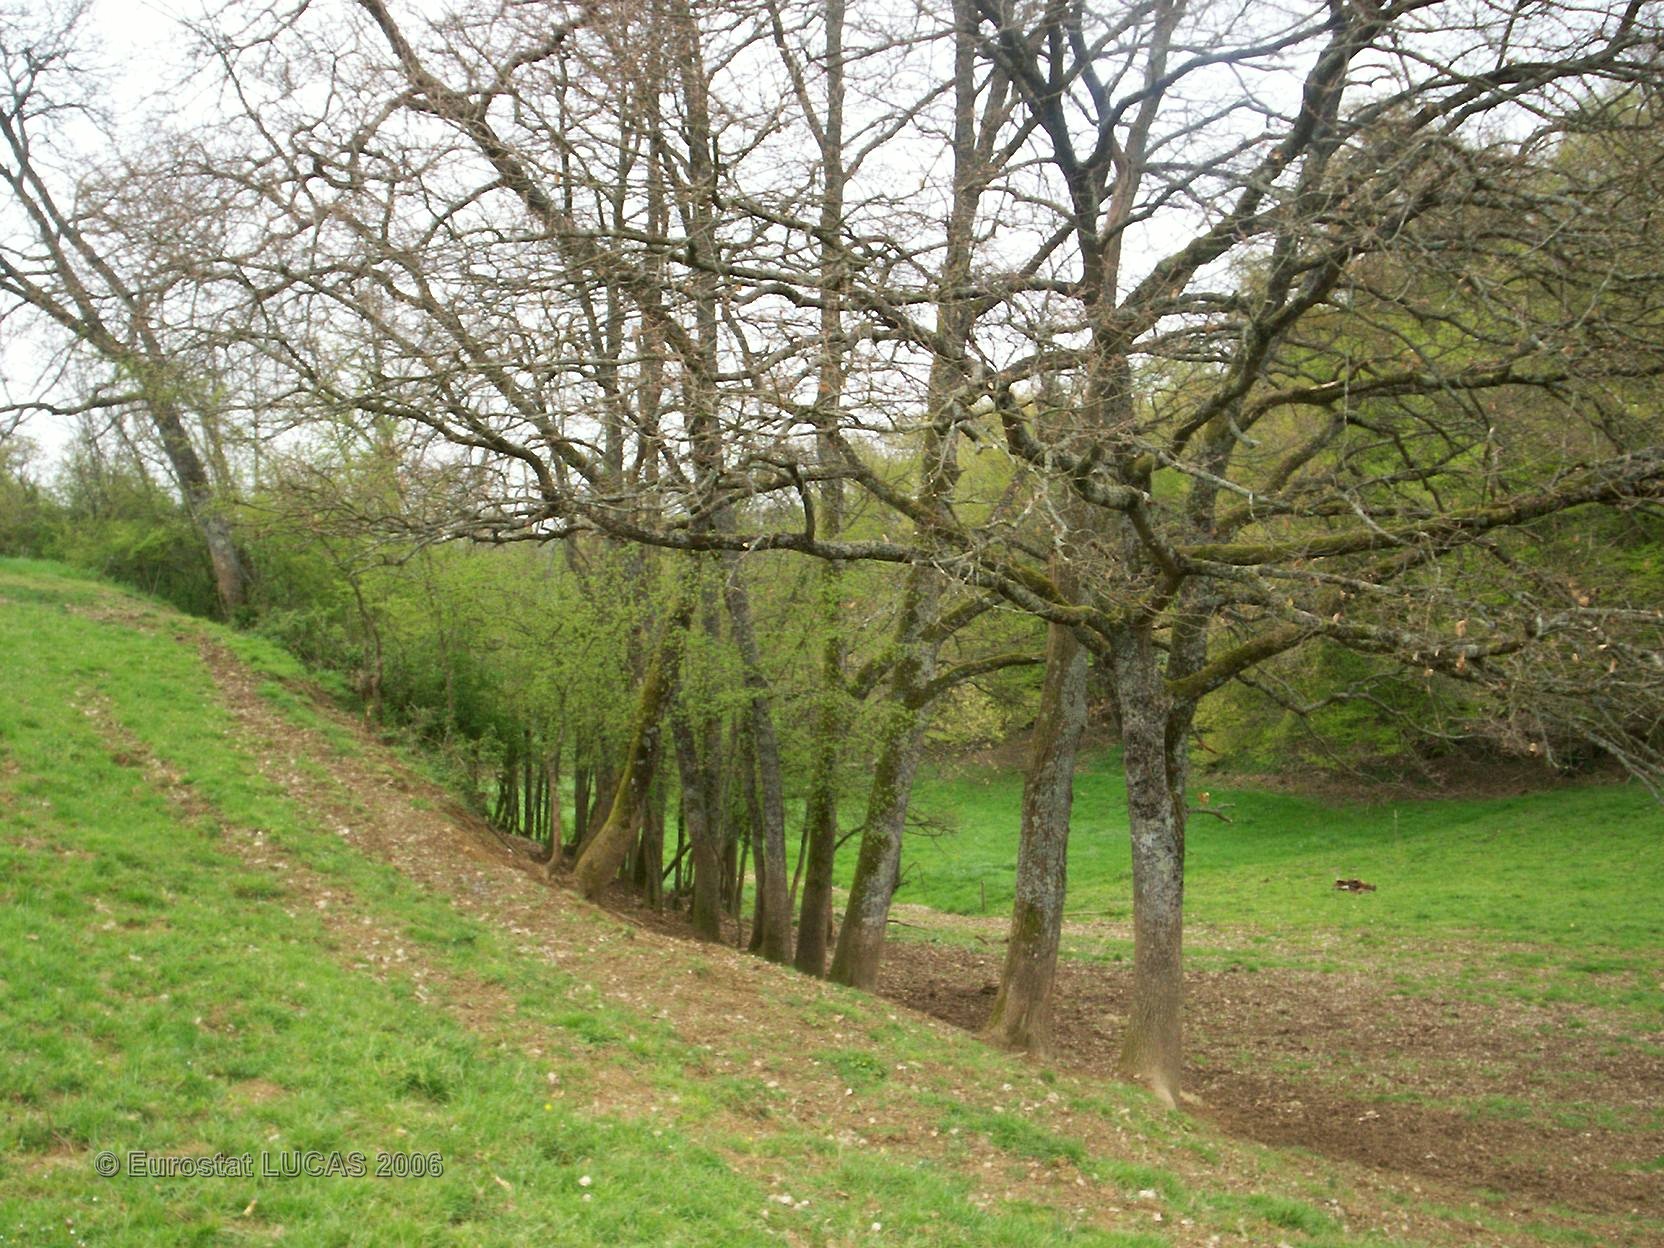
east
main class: Grassland
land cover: Grassland without tree/shrub cover
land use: Agriculture (excluding fallow land and kitchen gardens)
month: April
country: FR
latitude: 43.5614
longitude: 0.2280
